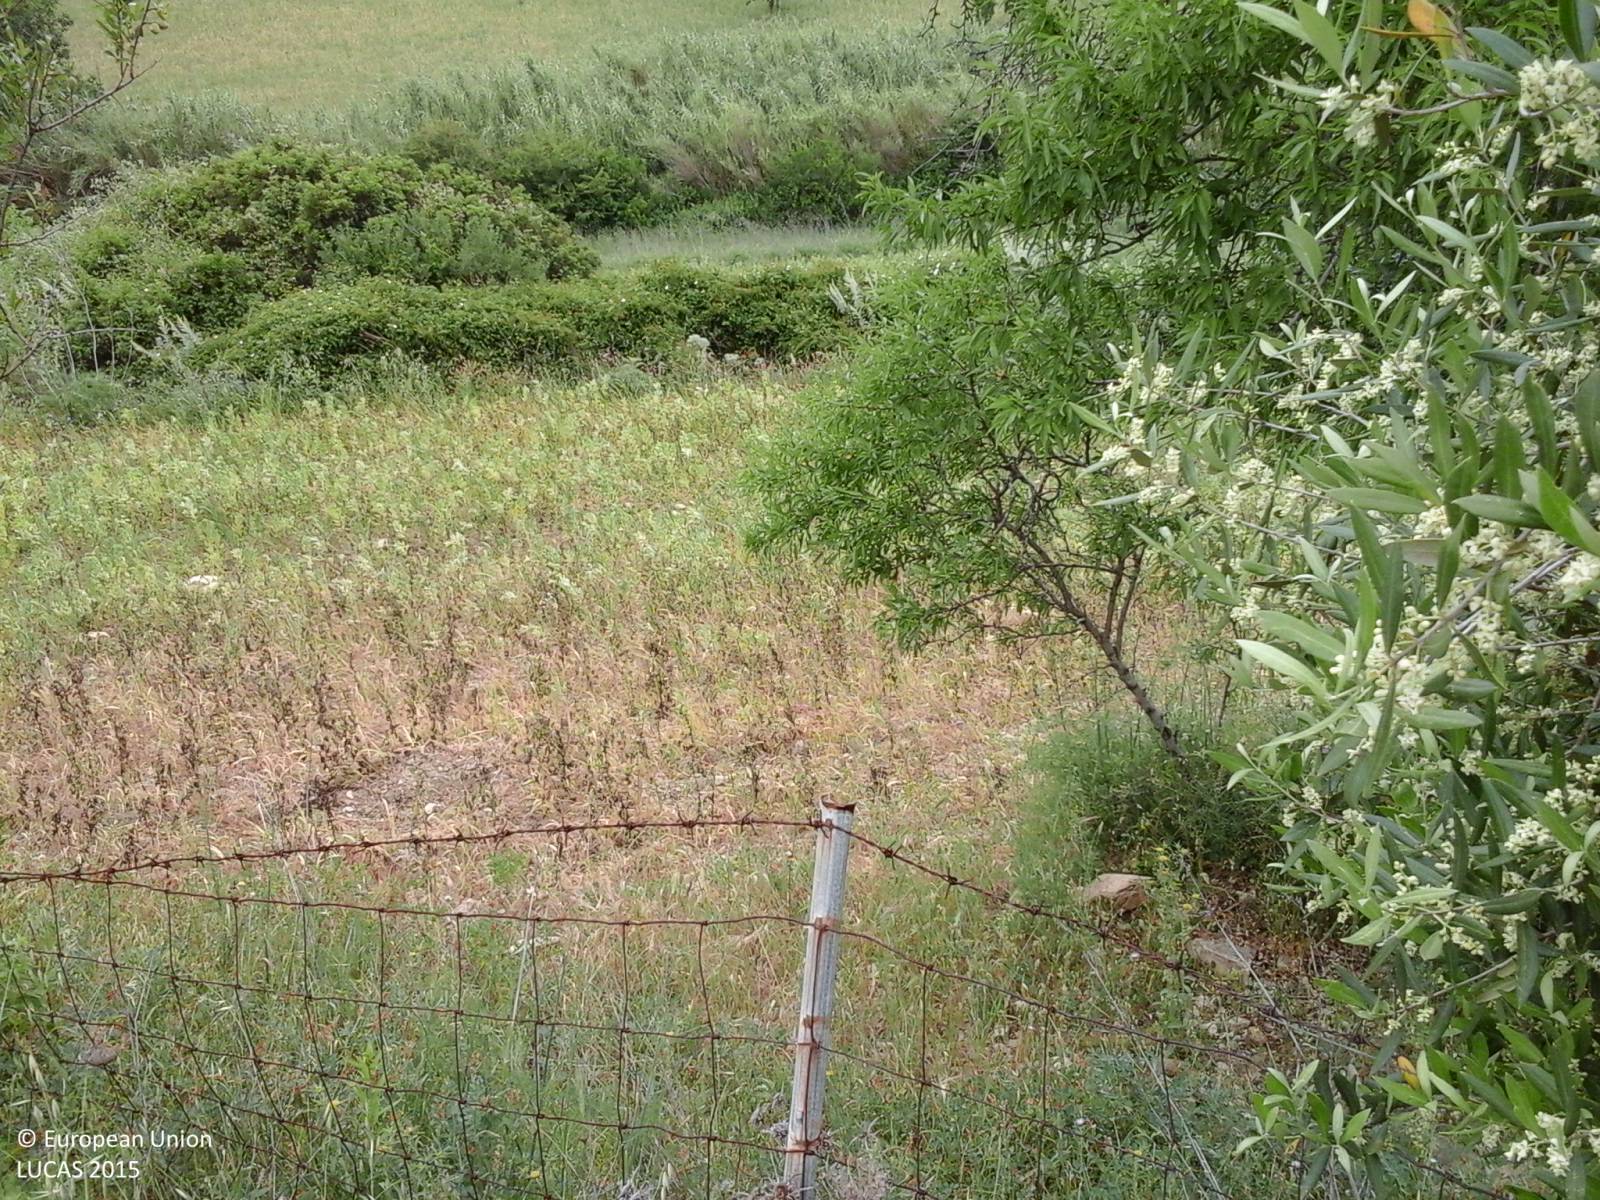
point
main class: Cropland
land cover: Dry pulses
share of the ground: 25 - 50 %
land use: Agriculture (excluding fallow land and kitchen gardens)
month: May
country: IT
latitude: 39.7346
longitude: 8.7818
